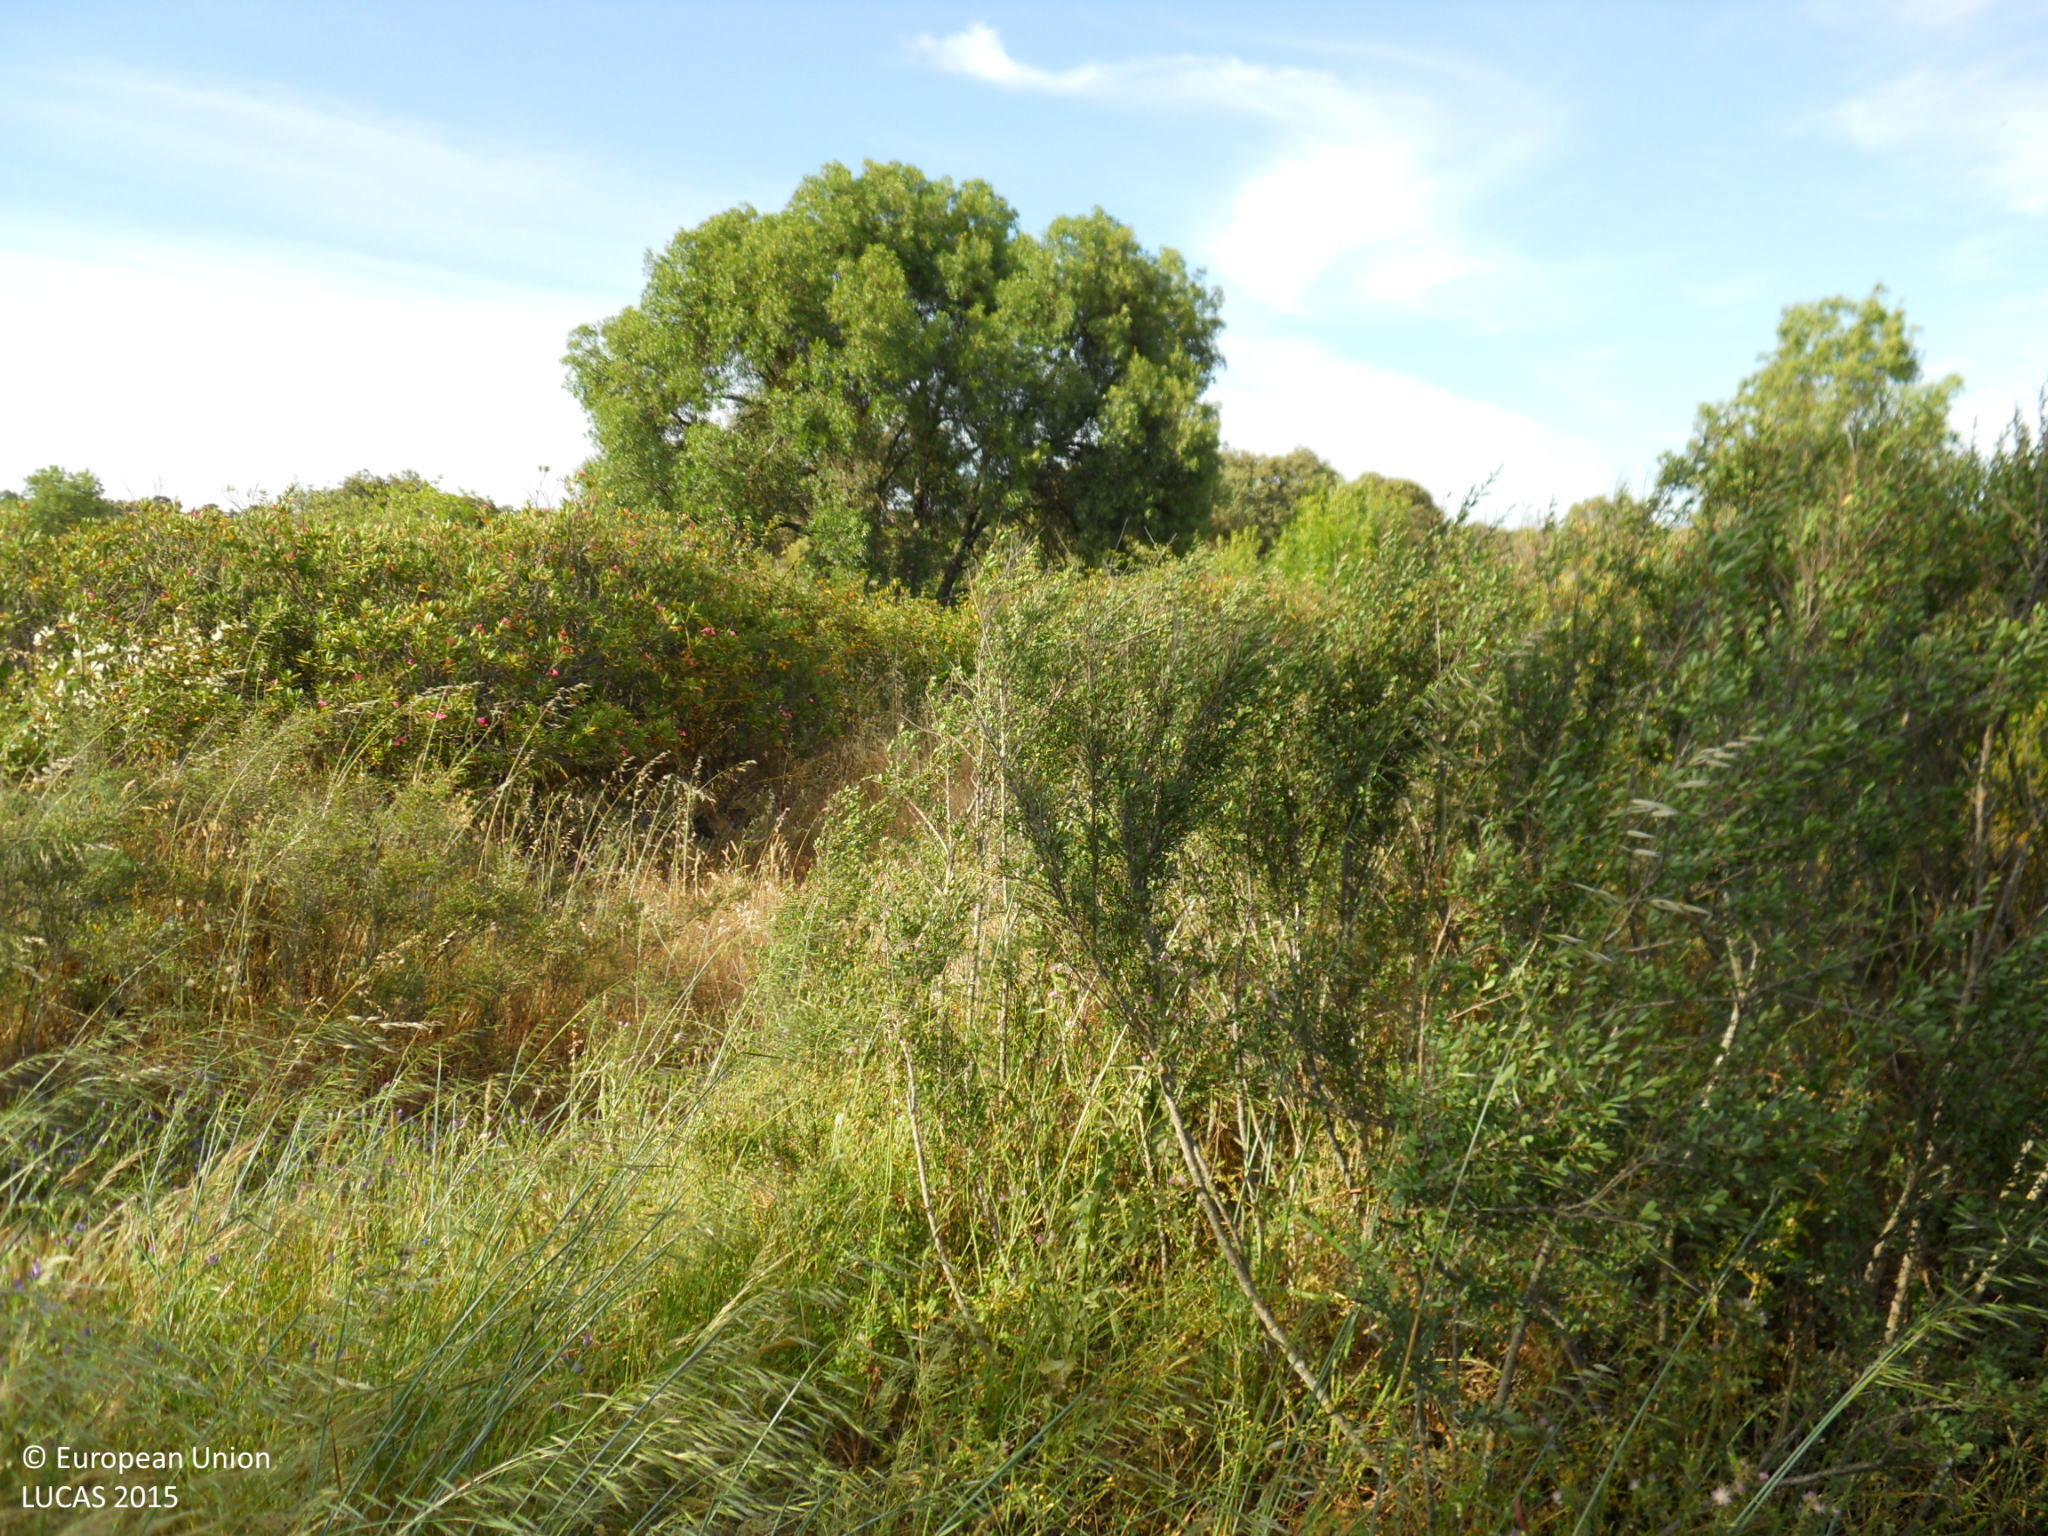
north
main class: Shrubland
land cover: Shrubland with sparse tree cover
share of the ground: > 75 %
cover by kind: shrubs 80 %, herbaceous plants 10 %, broadleaved forest trees 5 %, consolidated bare surface 5 %
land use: Agriculture (excluding fallow land and kitchen gardens)
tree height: > 5 m
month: May
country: ES
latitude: 39.0602
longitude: -6.2962
